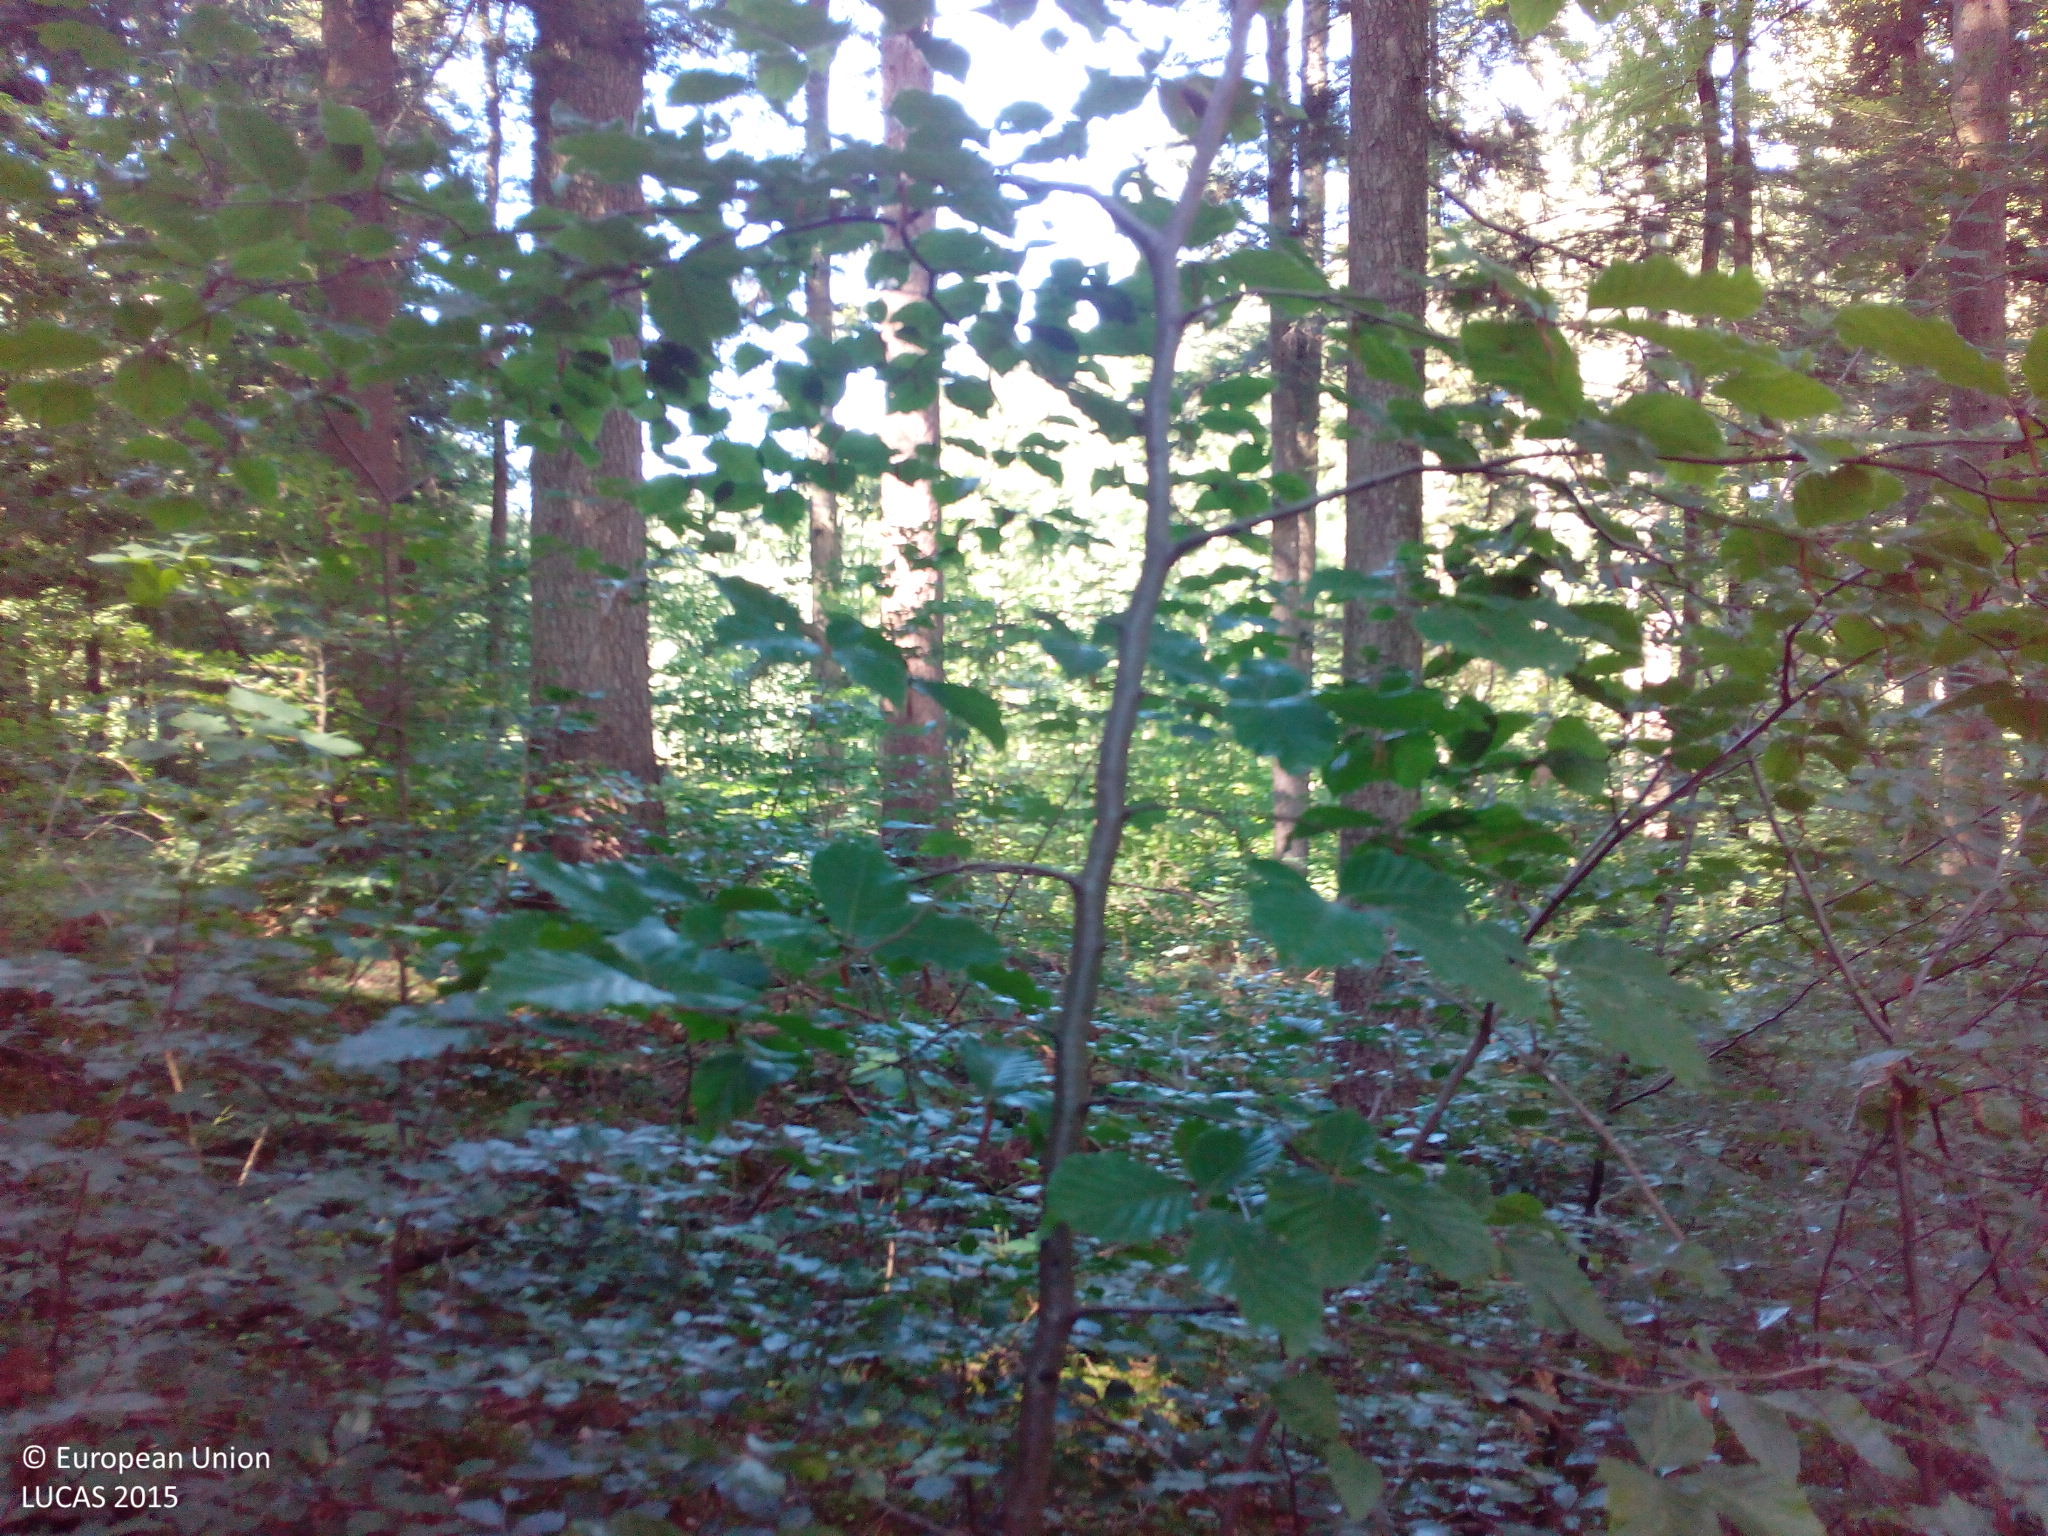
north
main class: Woodland
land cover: Spruce dominated coniferous woodland
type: hemiboreal forest and nemoral coniferous forest and mixed broadleaved-coniferous forest
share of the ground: > 75 %
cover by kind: coniferous forest trees 90 %, broadleaved forest trees 5 %, herbaceous plants 5 %
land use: Forestry
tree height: > 5 m
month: July
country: DE
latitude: 47.8525
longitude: 11.5626
